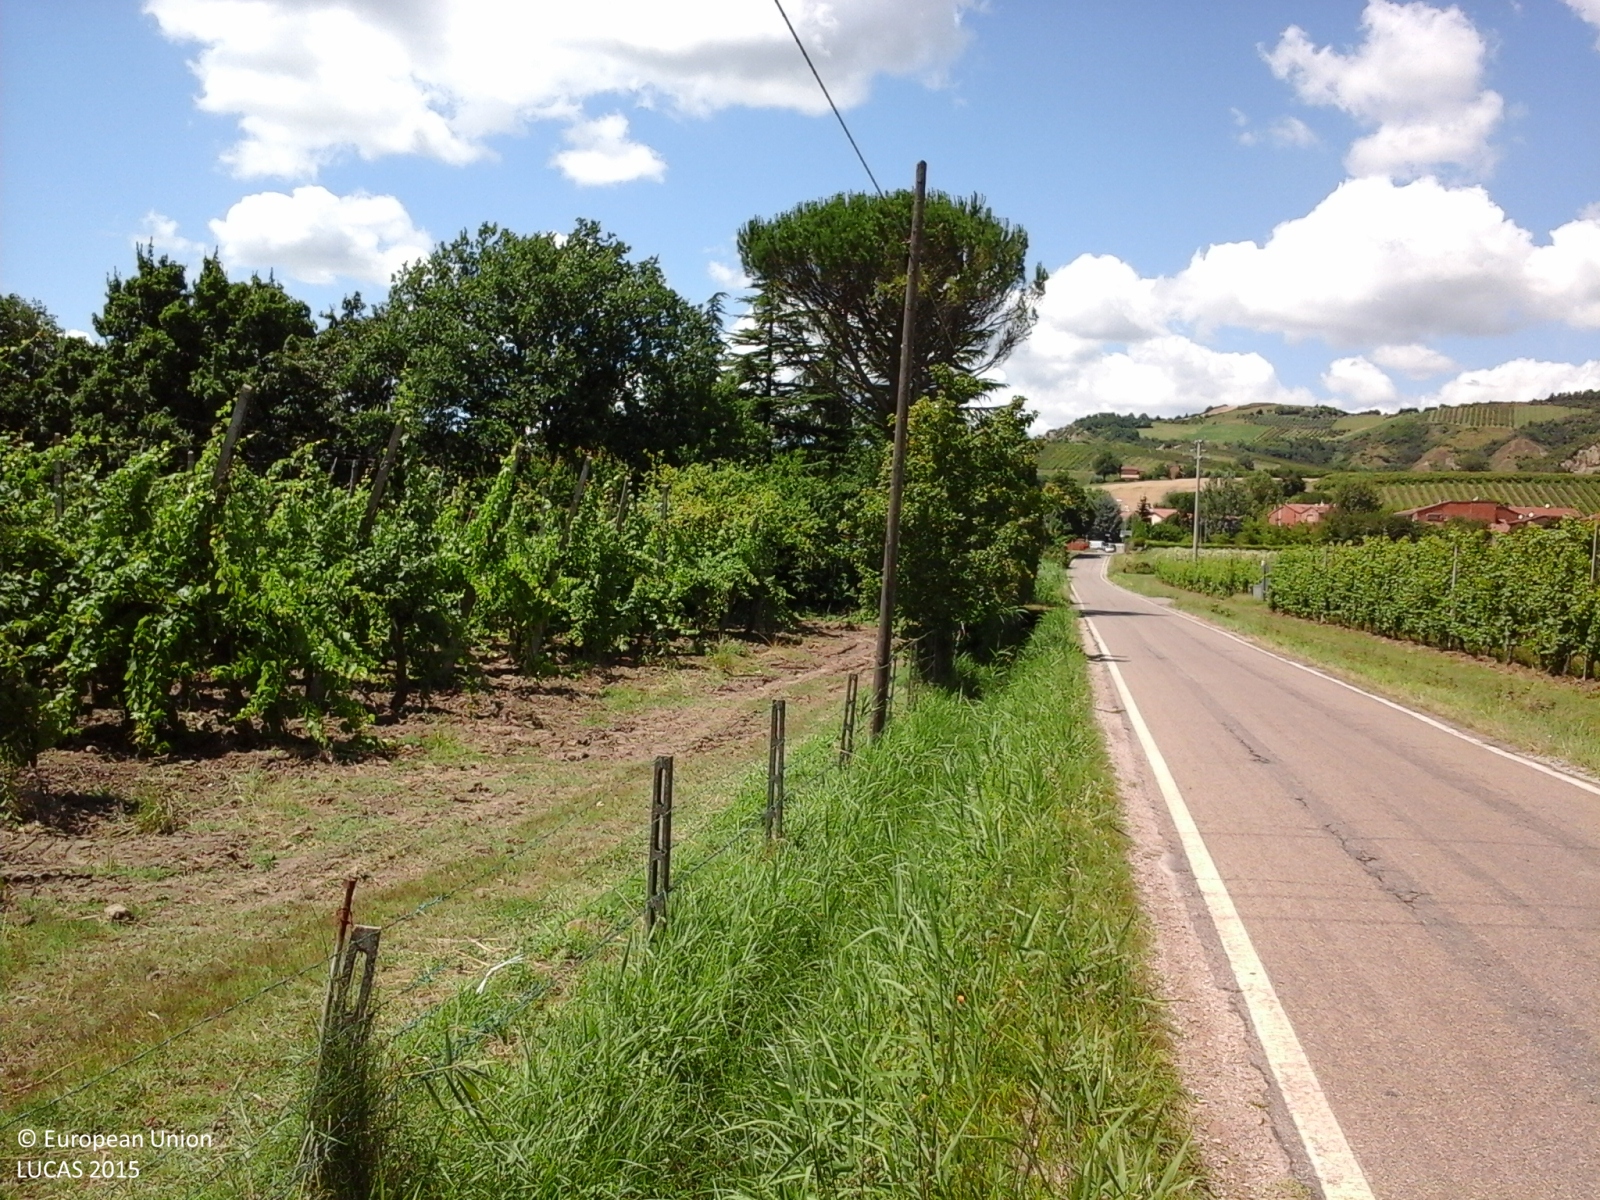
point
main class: Artificial land
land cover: Non built-up linear features
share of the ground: > 75 %
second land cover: Grassland without tree/shrub cover
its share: > 75 %
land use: Road transport
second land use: Agriculture (excluding fallow land and kitchen gardens)
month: June
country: IT
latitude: 44.3015
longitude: 11.6383
